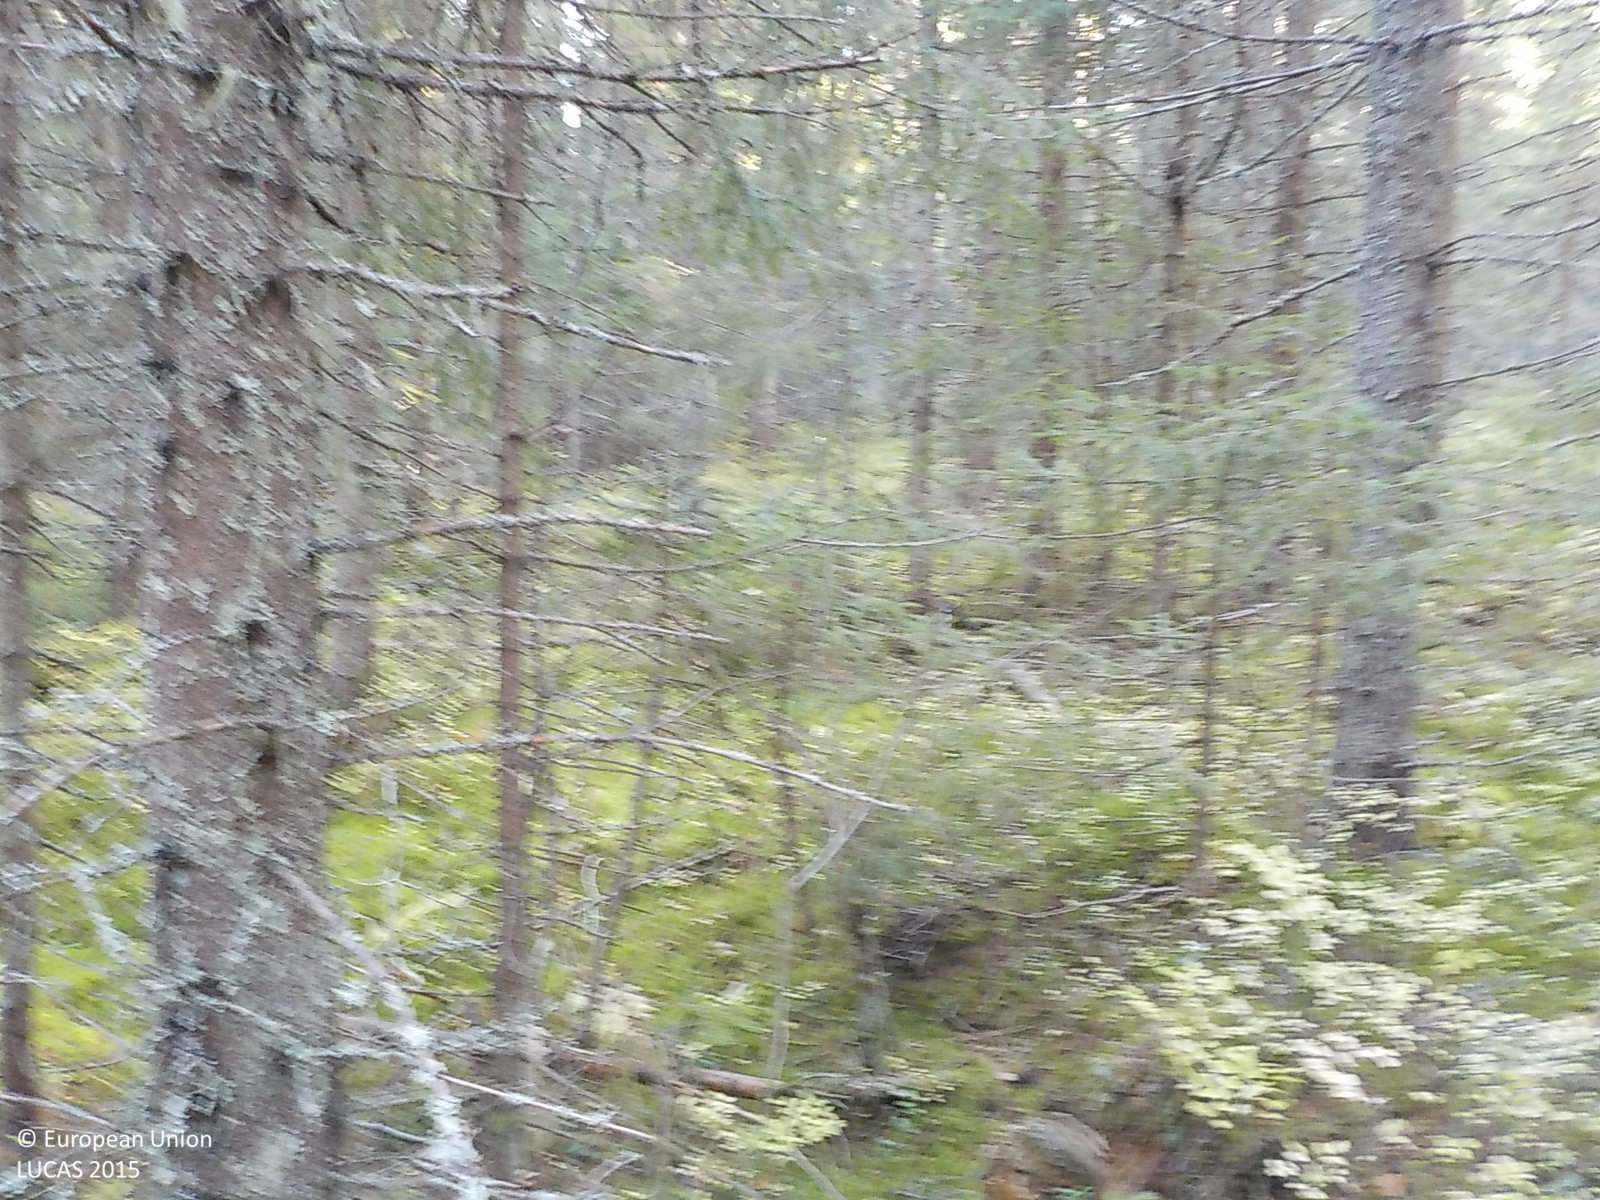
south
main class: Woodland
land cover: Spruce dominated coniferous woodland
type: boreal forest
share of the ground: > 75 %
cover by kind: coniferous forest trees 80 %, shrubs 20 %
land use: Forestry
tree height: > 5 m
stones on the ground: < 10 %
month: October
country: SE
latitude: 63.2658
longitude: 18.0860
